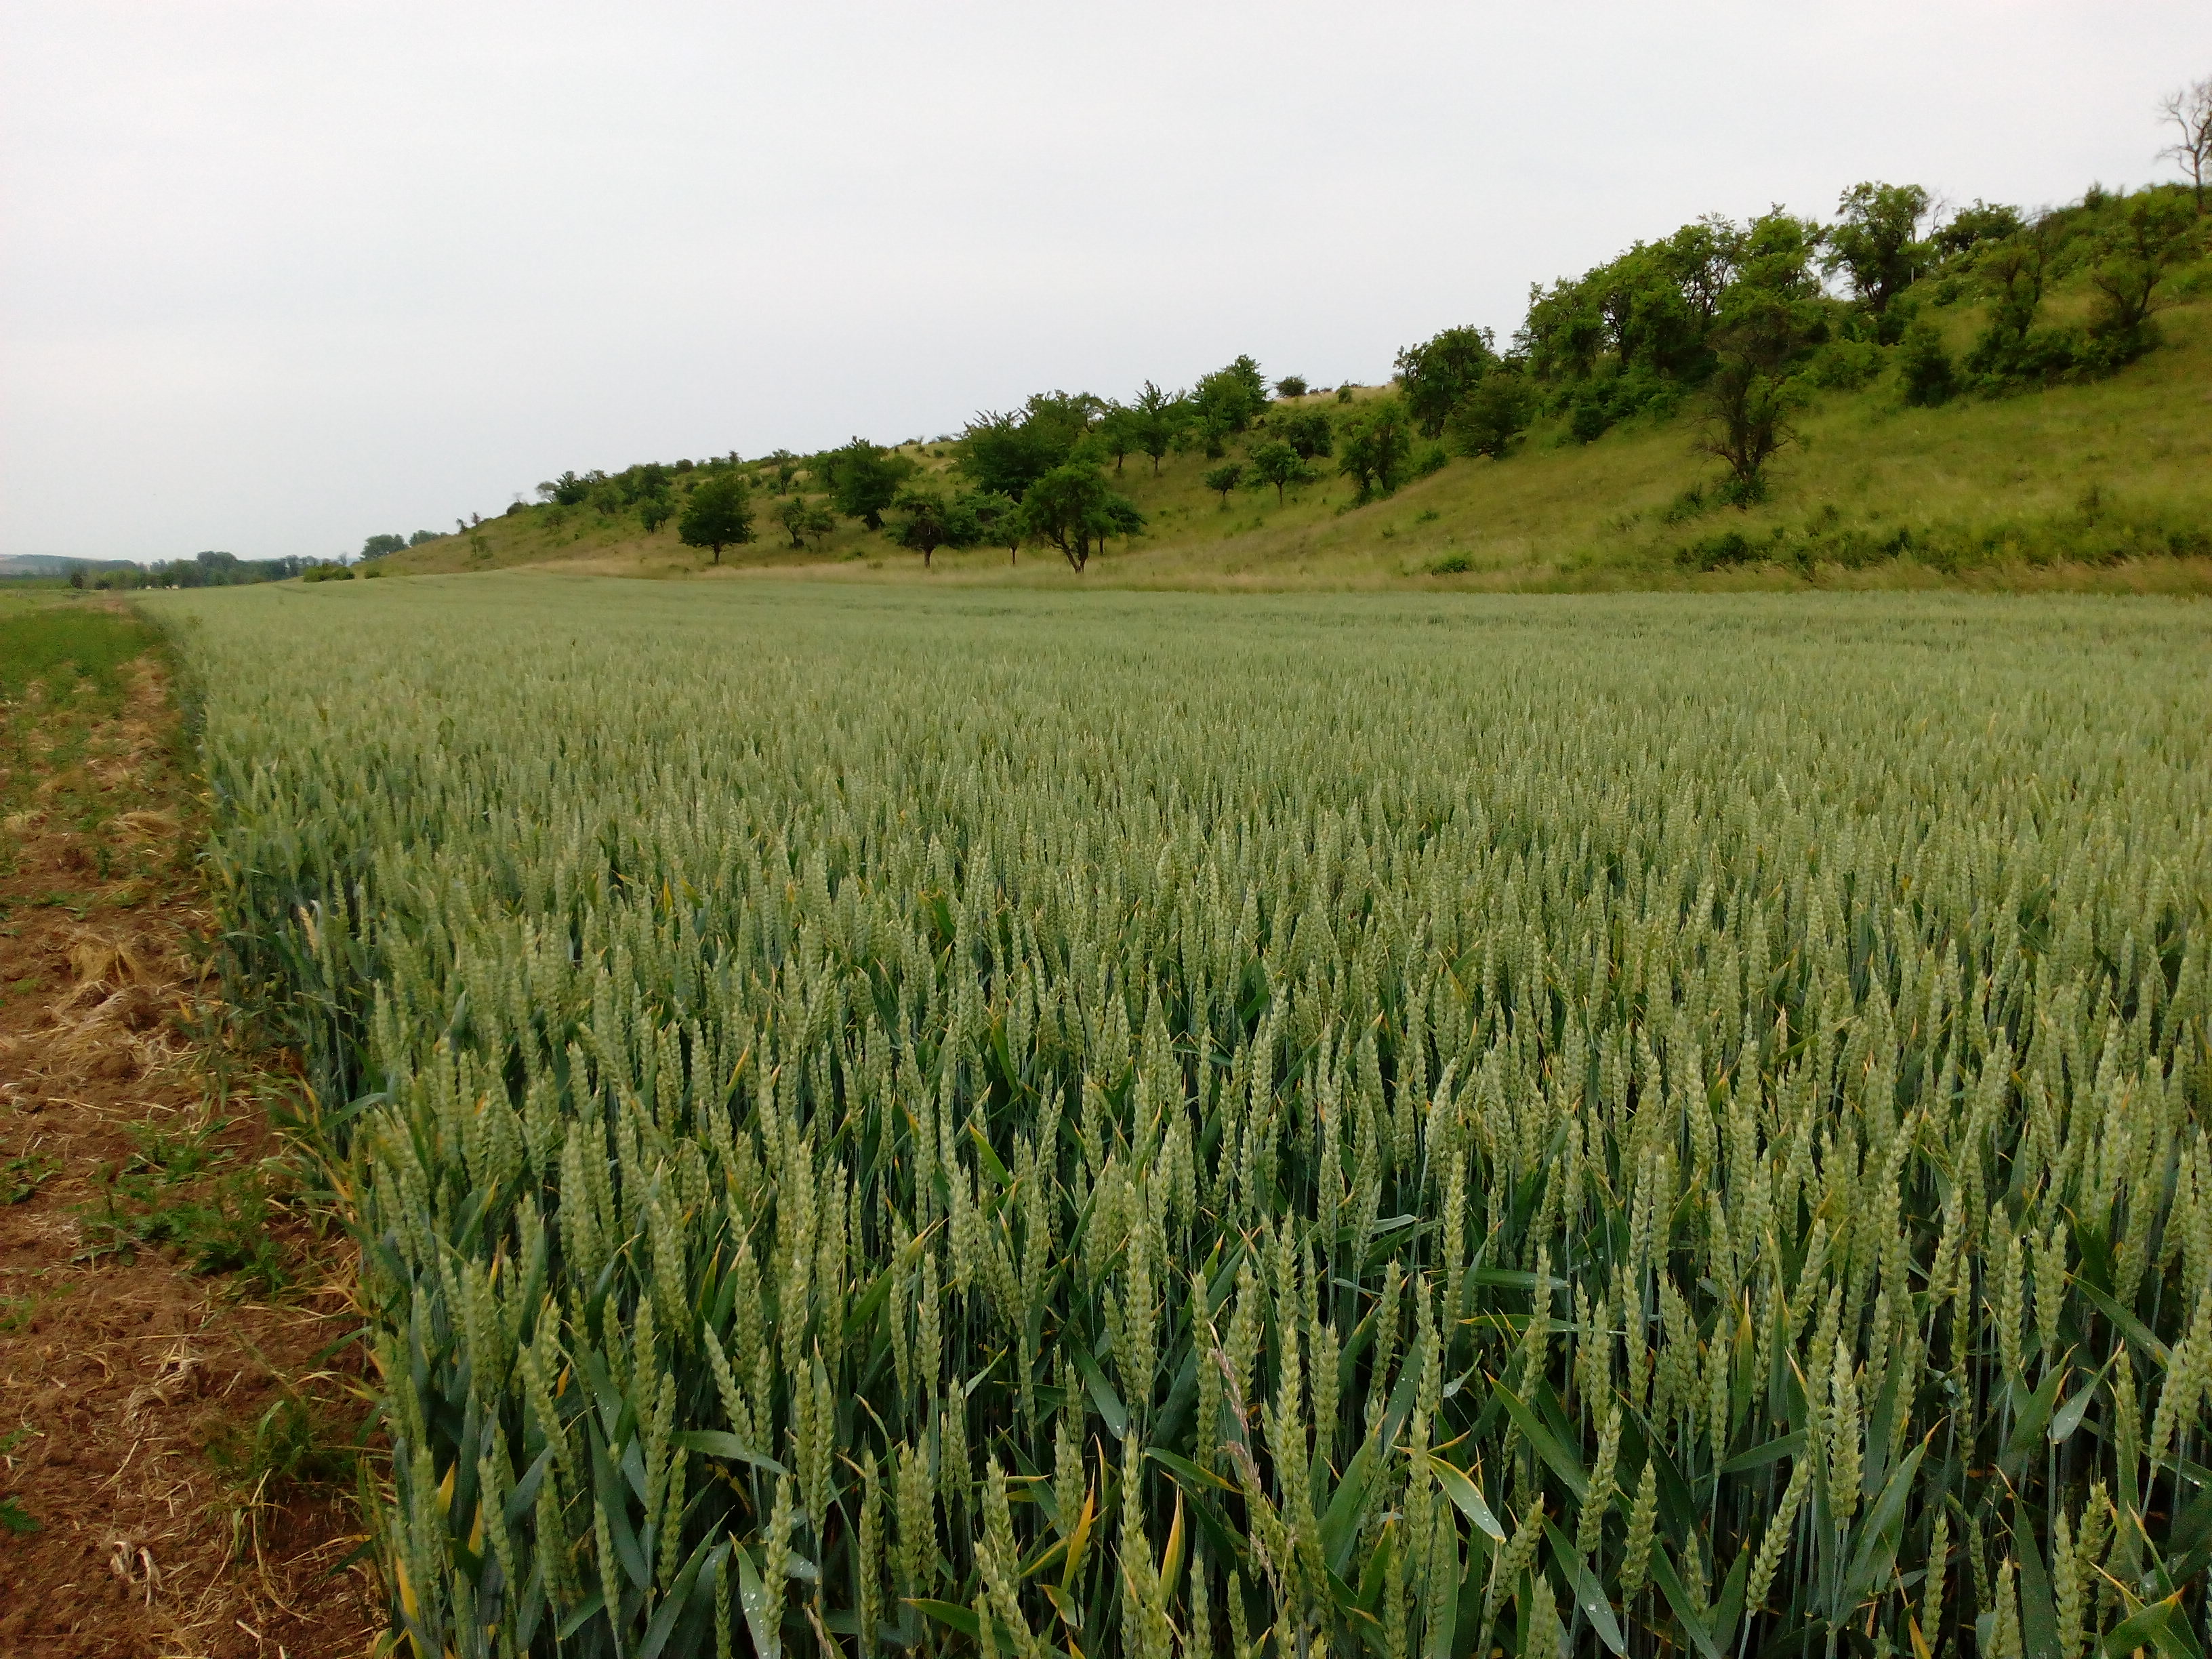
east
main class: Grassland
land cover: Grassland with sparse tree/shrub cover
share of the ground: > 75 %
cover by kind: herbaceous plants 95 %, broadleaved forest trees 5 %
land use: Agriculture (excluding fallow land and kitchen gardens)
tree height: > 5 m
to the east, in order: Grassland with sparse tree/shrub cover; Grassland without tree/shrub cover; Grassland with sparse tree/shrub cover; Grassland without tree/shrub cover; Lines of trees; Grassland without tree/shrub cover
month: June
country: DE
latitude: 51.2585
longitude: 11.0171
